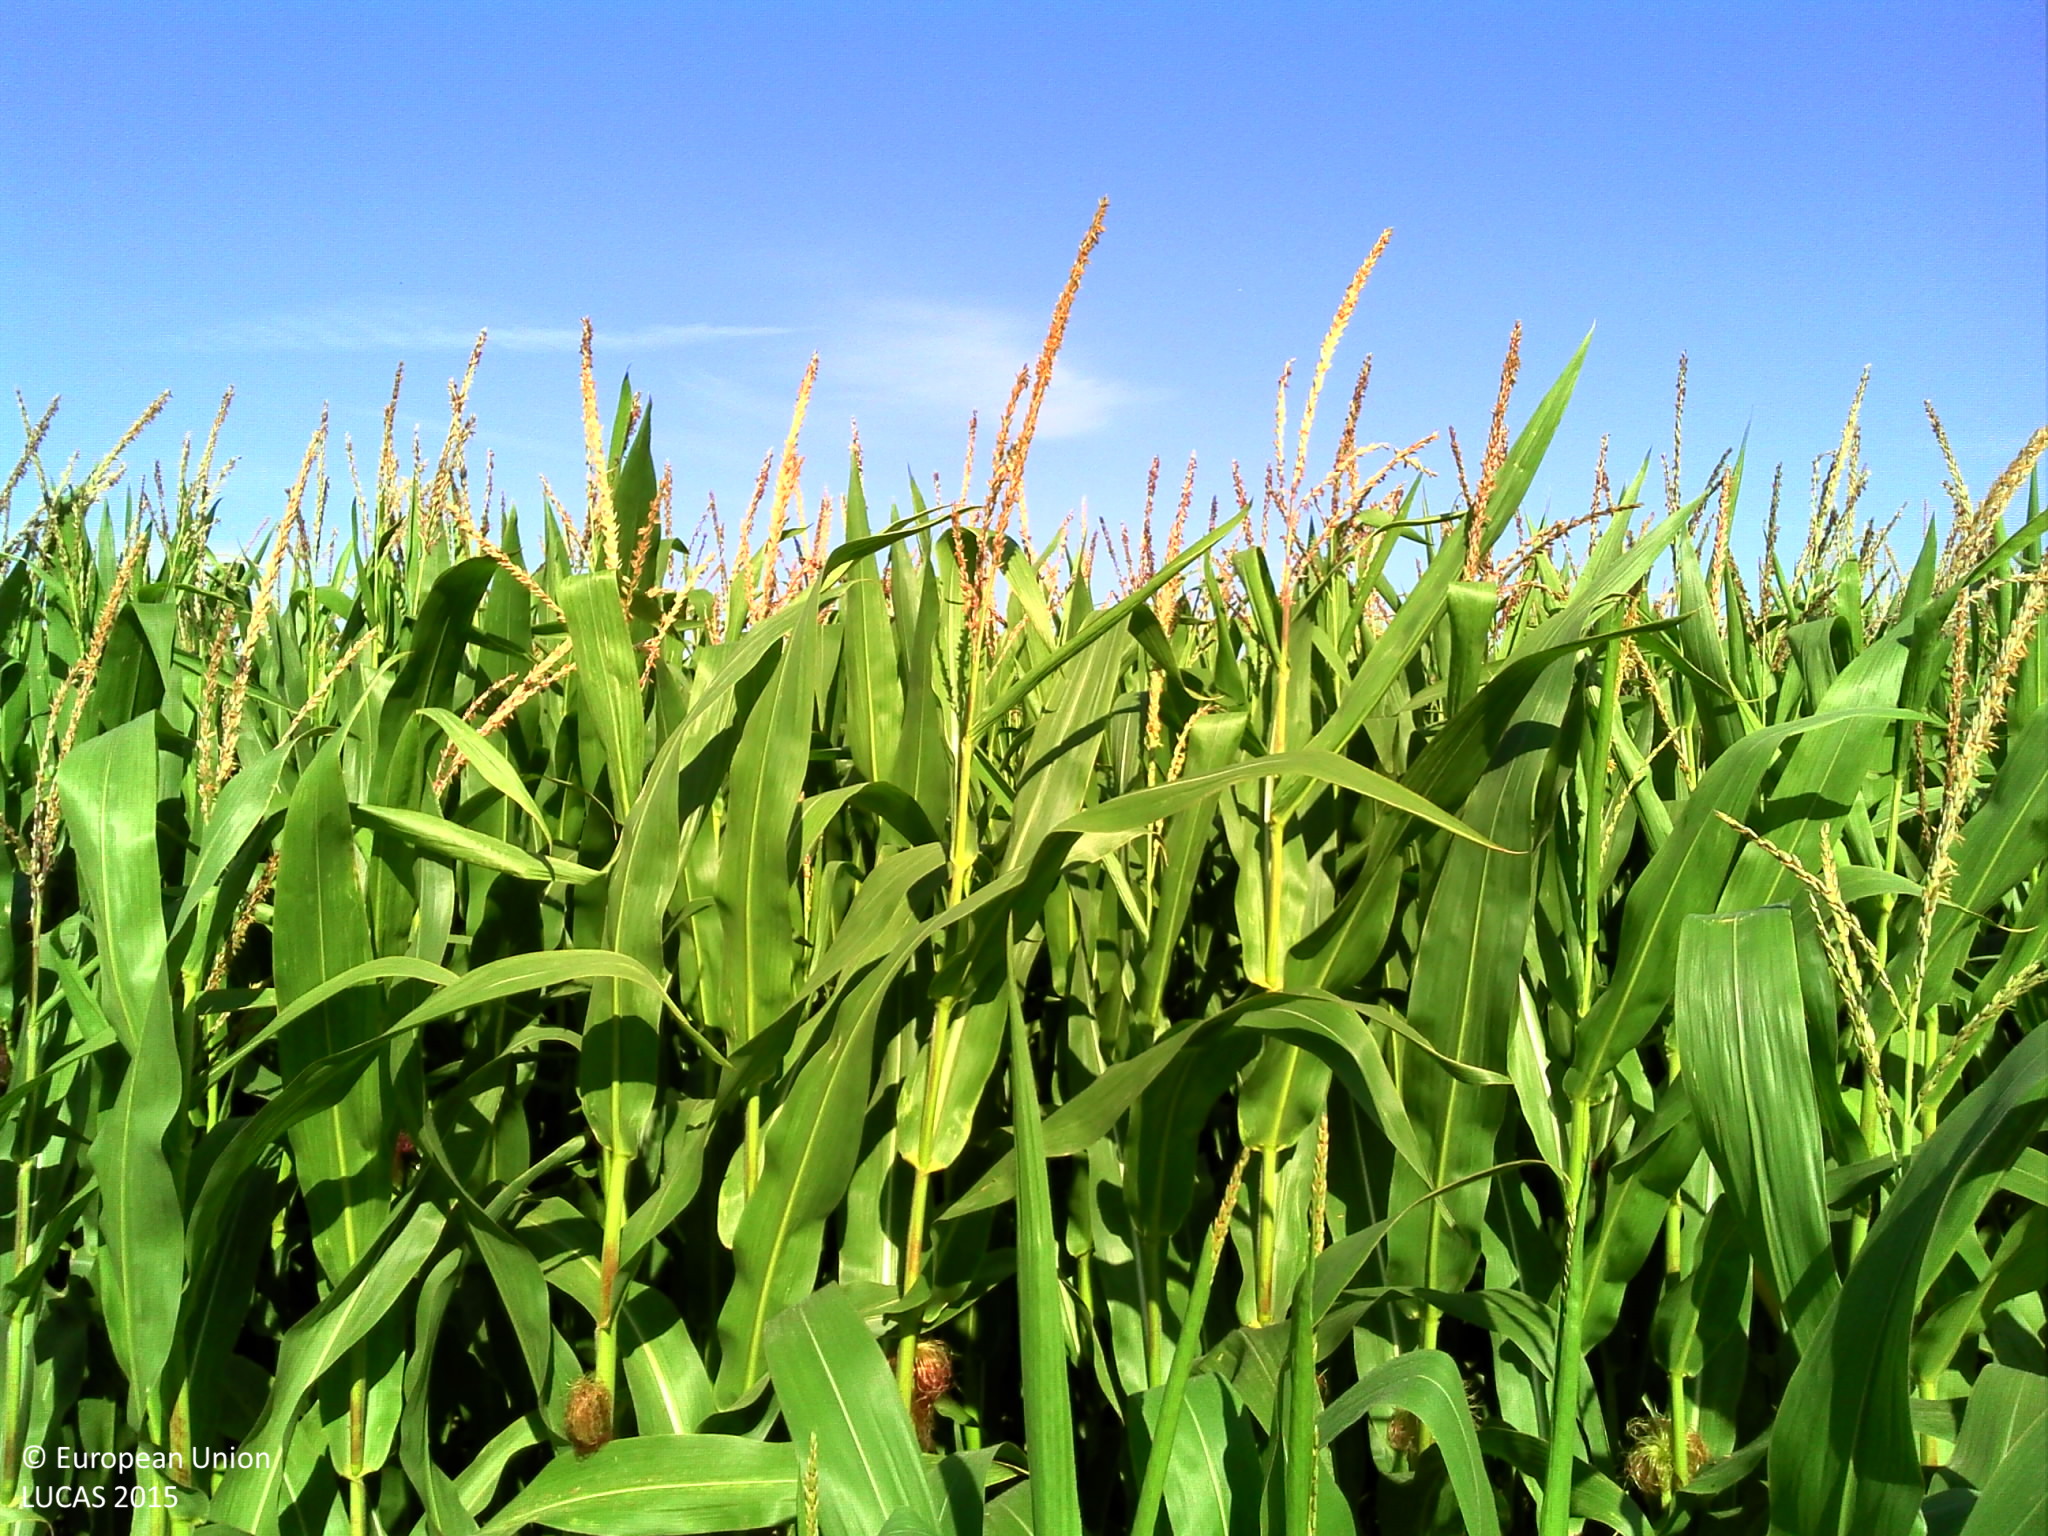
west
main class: Cropland
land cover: Maize
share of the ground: > 75 %
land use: Agriculture (excluding fallow land and kitchen gardens)
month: August
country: FR
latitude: 50.1684
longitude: 3.9601
